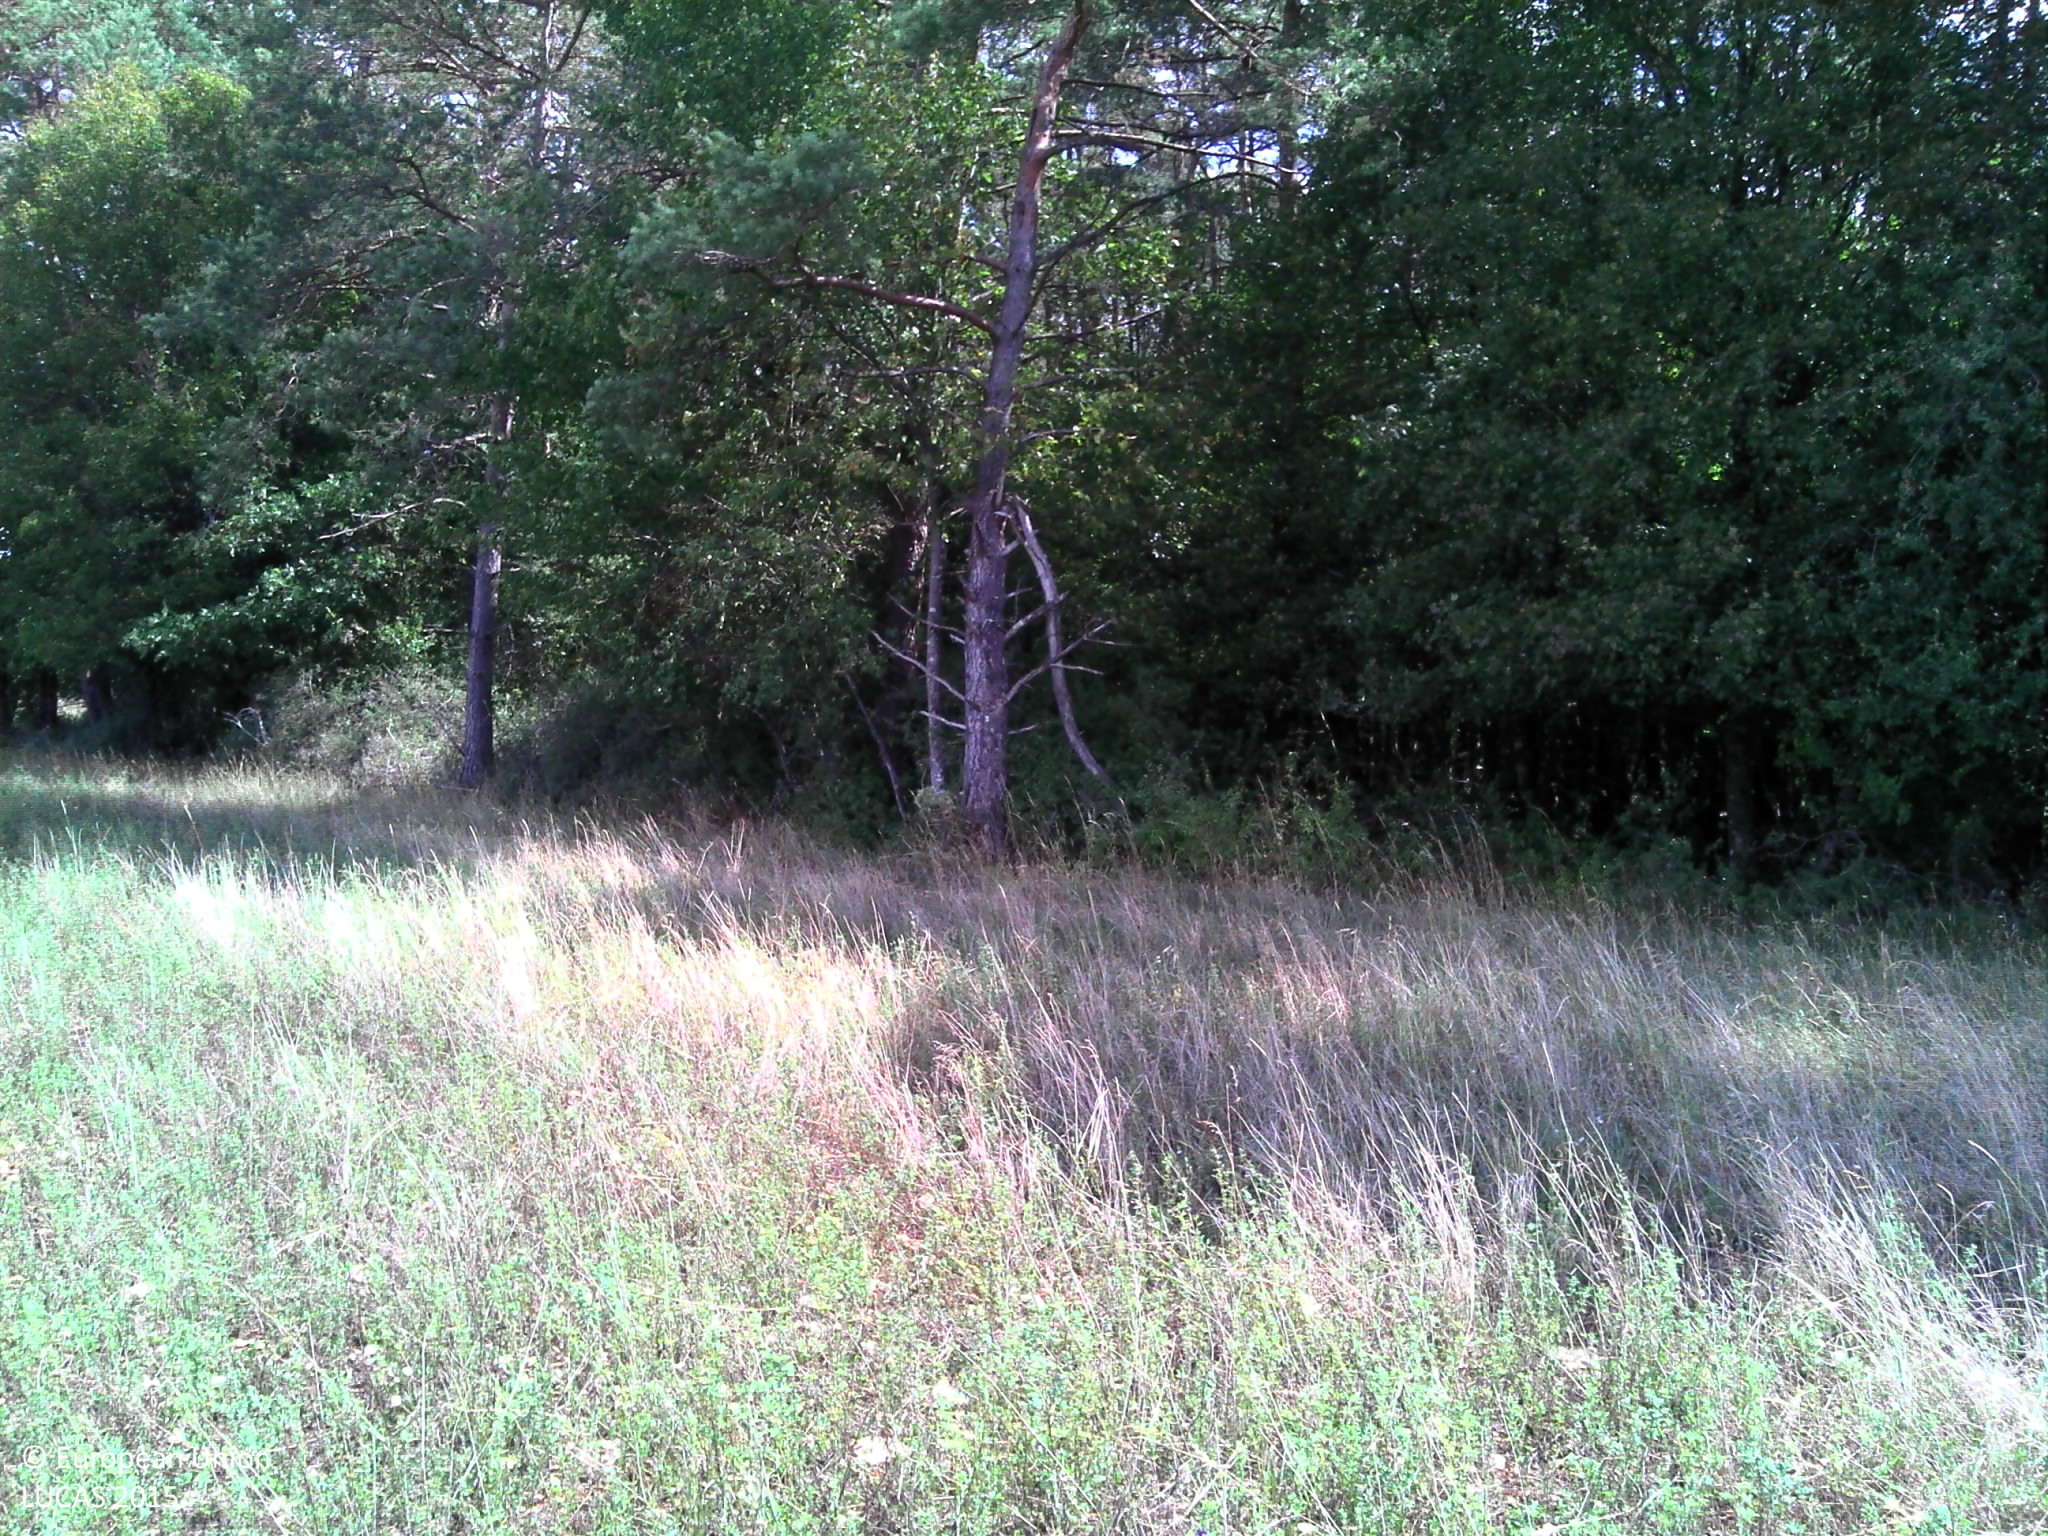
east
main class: Cropland
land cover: Lucerne
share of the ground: > 75 %
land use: Agriculture (excluding fallow land and kitchen gardens)
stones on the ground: 10 - 25 %
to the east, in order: Lucerne; Pine dominated mixed woodland; Broadleaved woodland
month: August
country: FR
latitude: 47.8831
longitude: 4.7703
